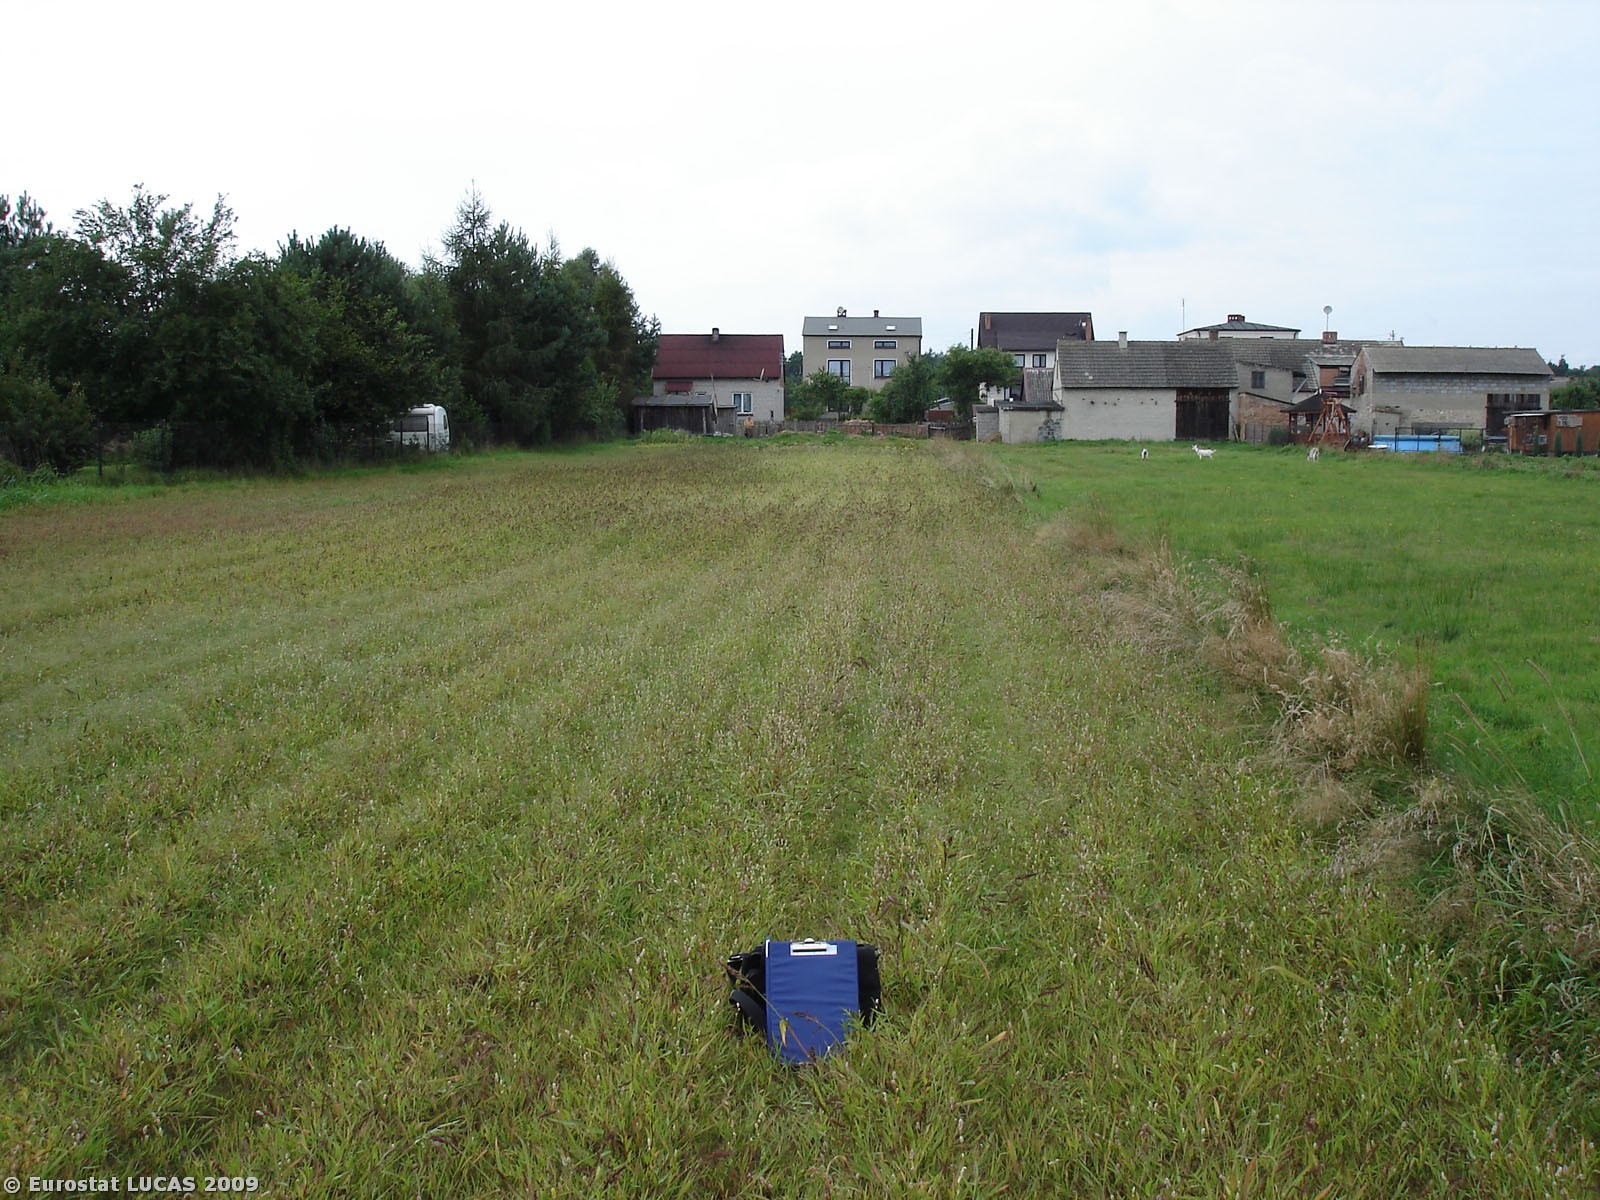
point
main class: Grassland
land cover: Grassland without tree/shrub cover
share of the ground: > 75 %
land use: Agriculture (excluding fallow land and kitchen gardens)
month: August
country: PL
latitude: 50.8175
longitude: 18.8364
